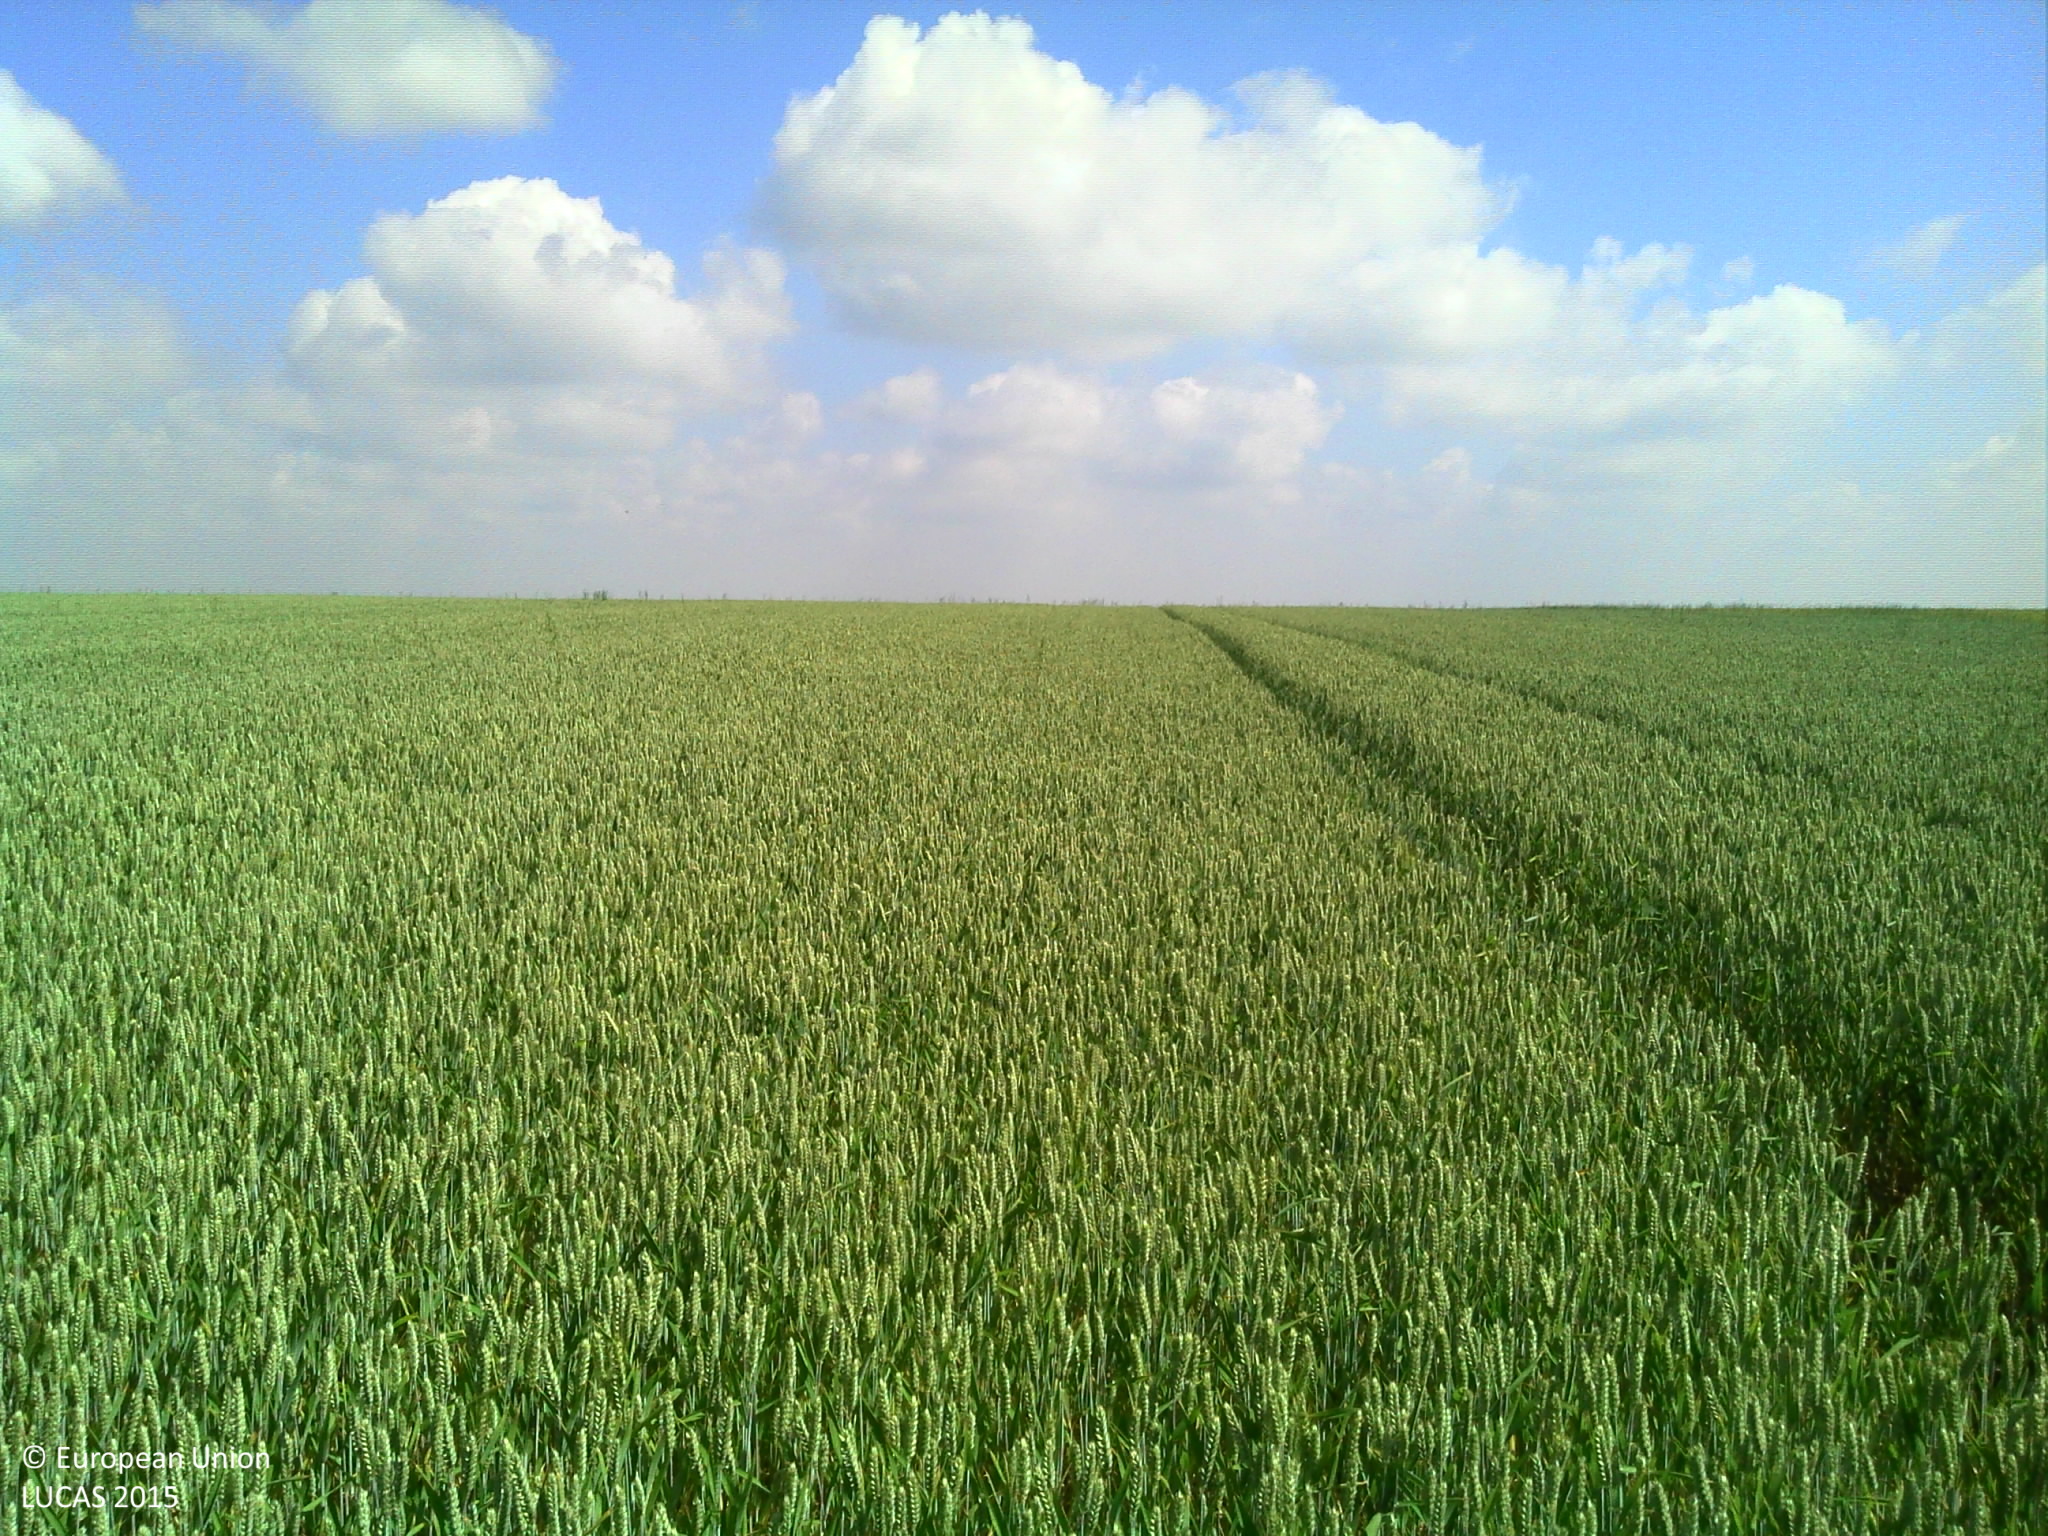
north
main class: Cropland
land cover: Common wheat
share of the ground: > 75 %
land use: Agriculture (excluding fallow land and kitchen gardens)
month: June
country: FR
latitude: 48.6294
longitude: 0.1070
